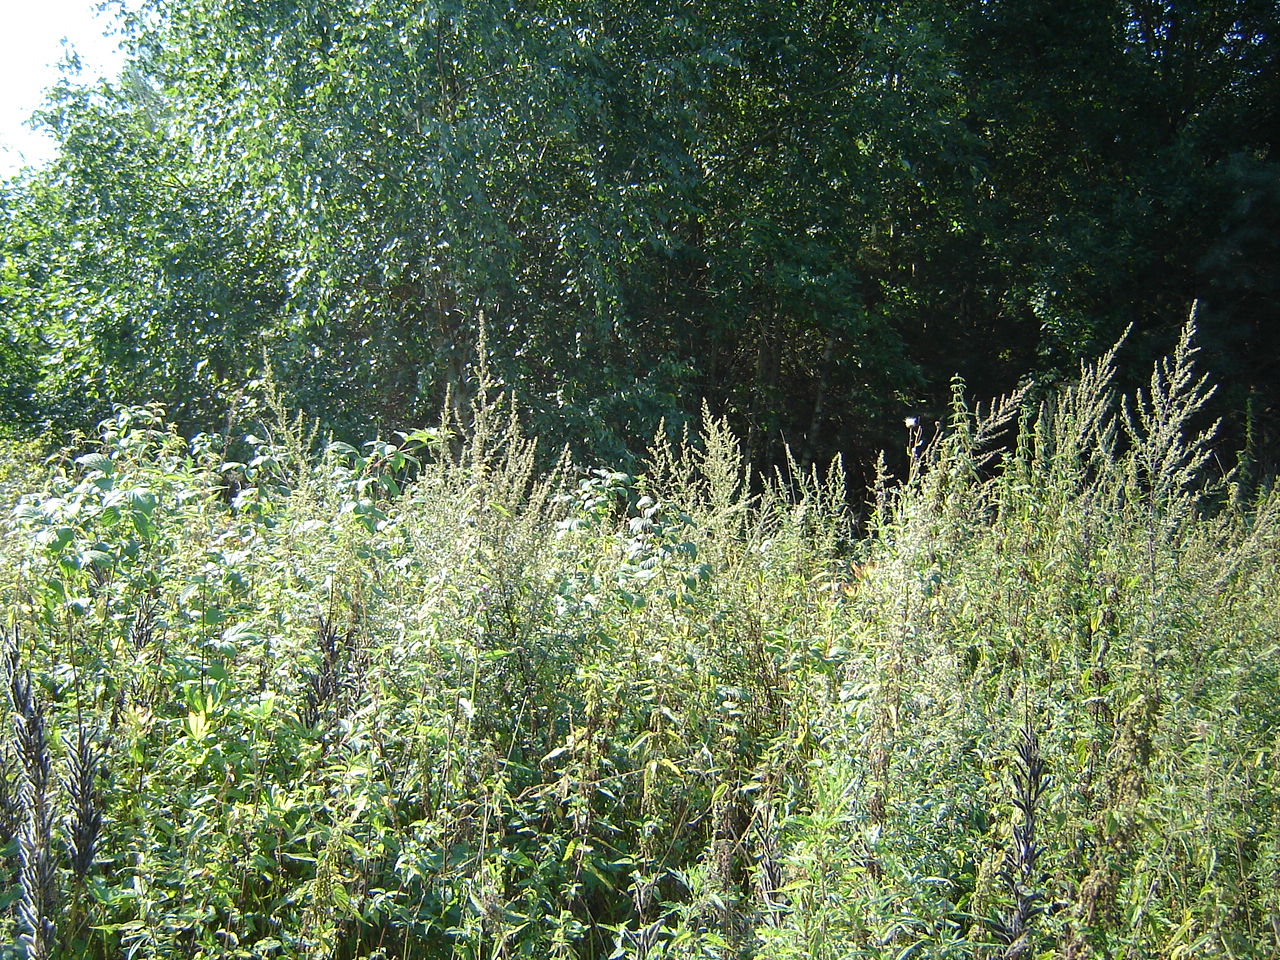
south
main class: Woodland
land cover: Pine dominated mixed woodland
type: hemiboreal forest and nemoral coniferous forest and mixed broadleaved-coniferous forest
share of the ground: > 75 %
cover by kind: coniferous forest trees 45 %, broadleaved forest trees 45 %, herbaceous plants 10 %
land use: Forestry
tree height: > 5 m
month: August
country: LT
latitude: 54.8858
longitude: 24.7775
